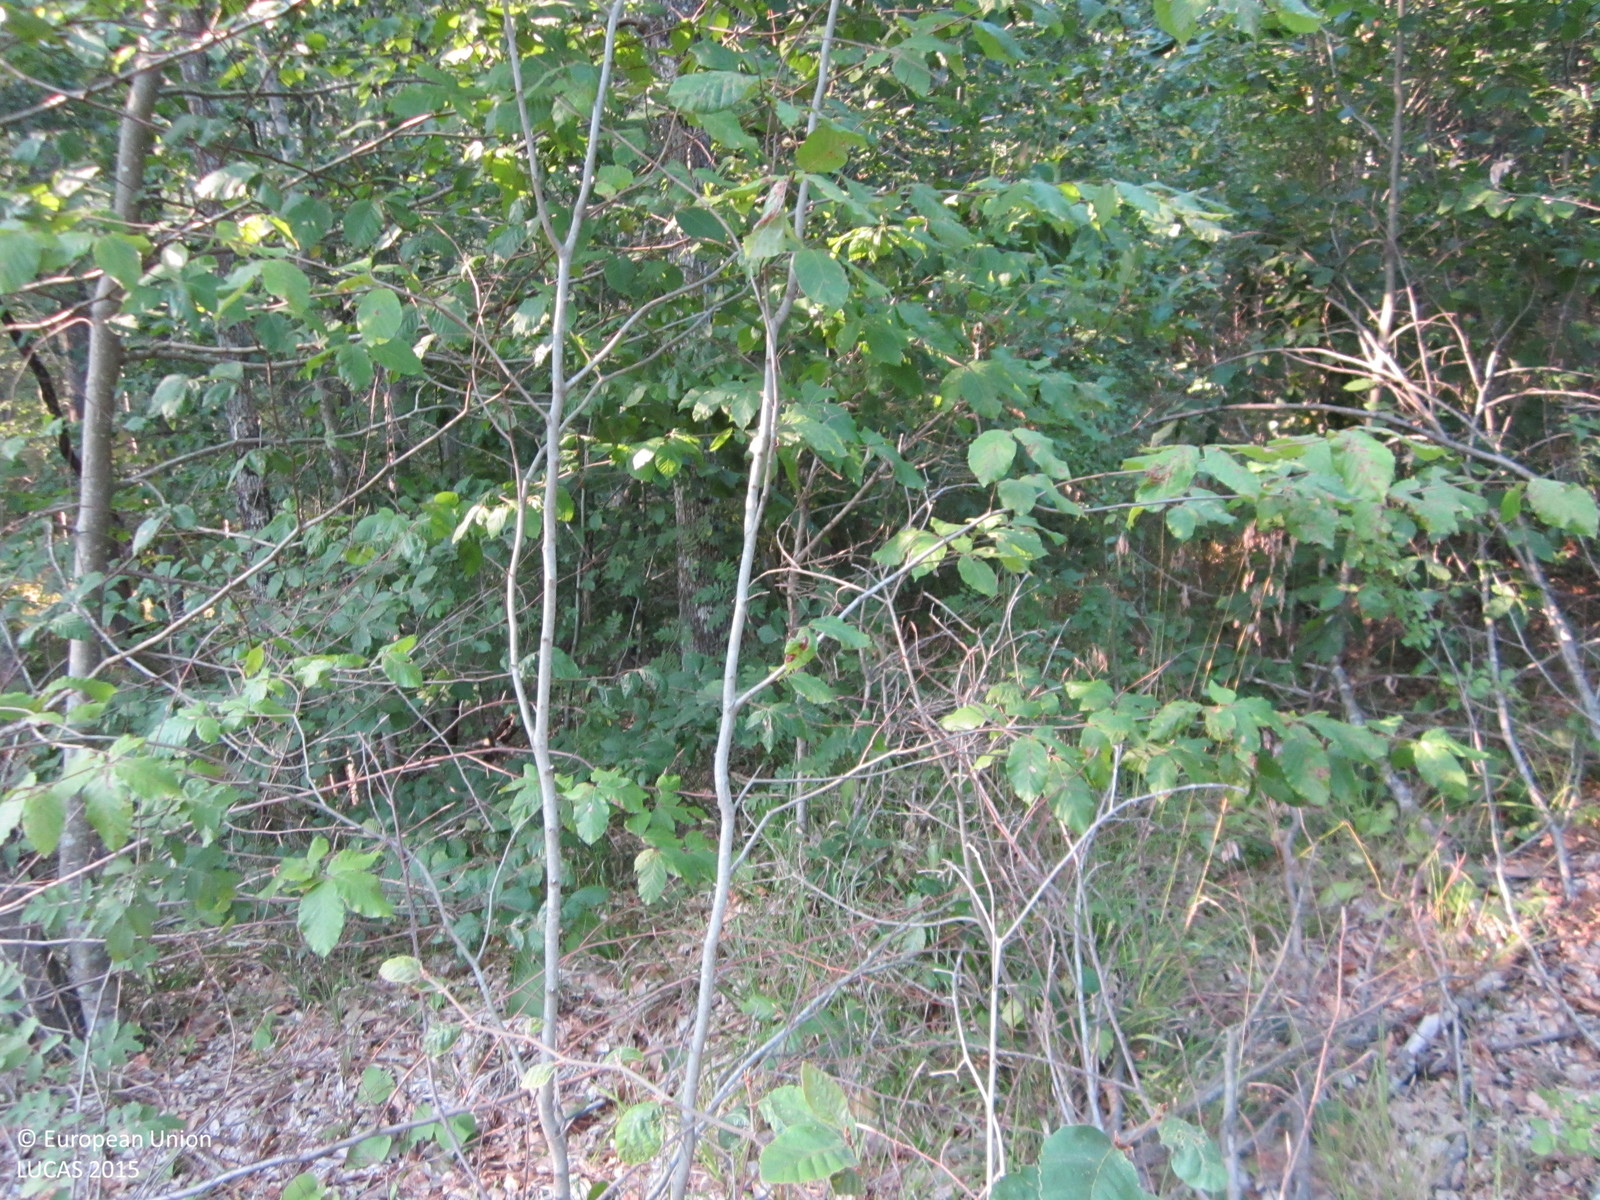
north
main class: Woodland
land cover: Broadleaved woodland
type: thermophilous deciduous forest
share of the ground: > 75 %
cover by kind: broadleaved forest trees 90 %, shrubs 5 %, herbaceous plants 5 %
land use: Forestry
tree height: > 5 m
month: August
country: BG
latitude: 42.1584
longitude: 27.6542
